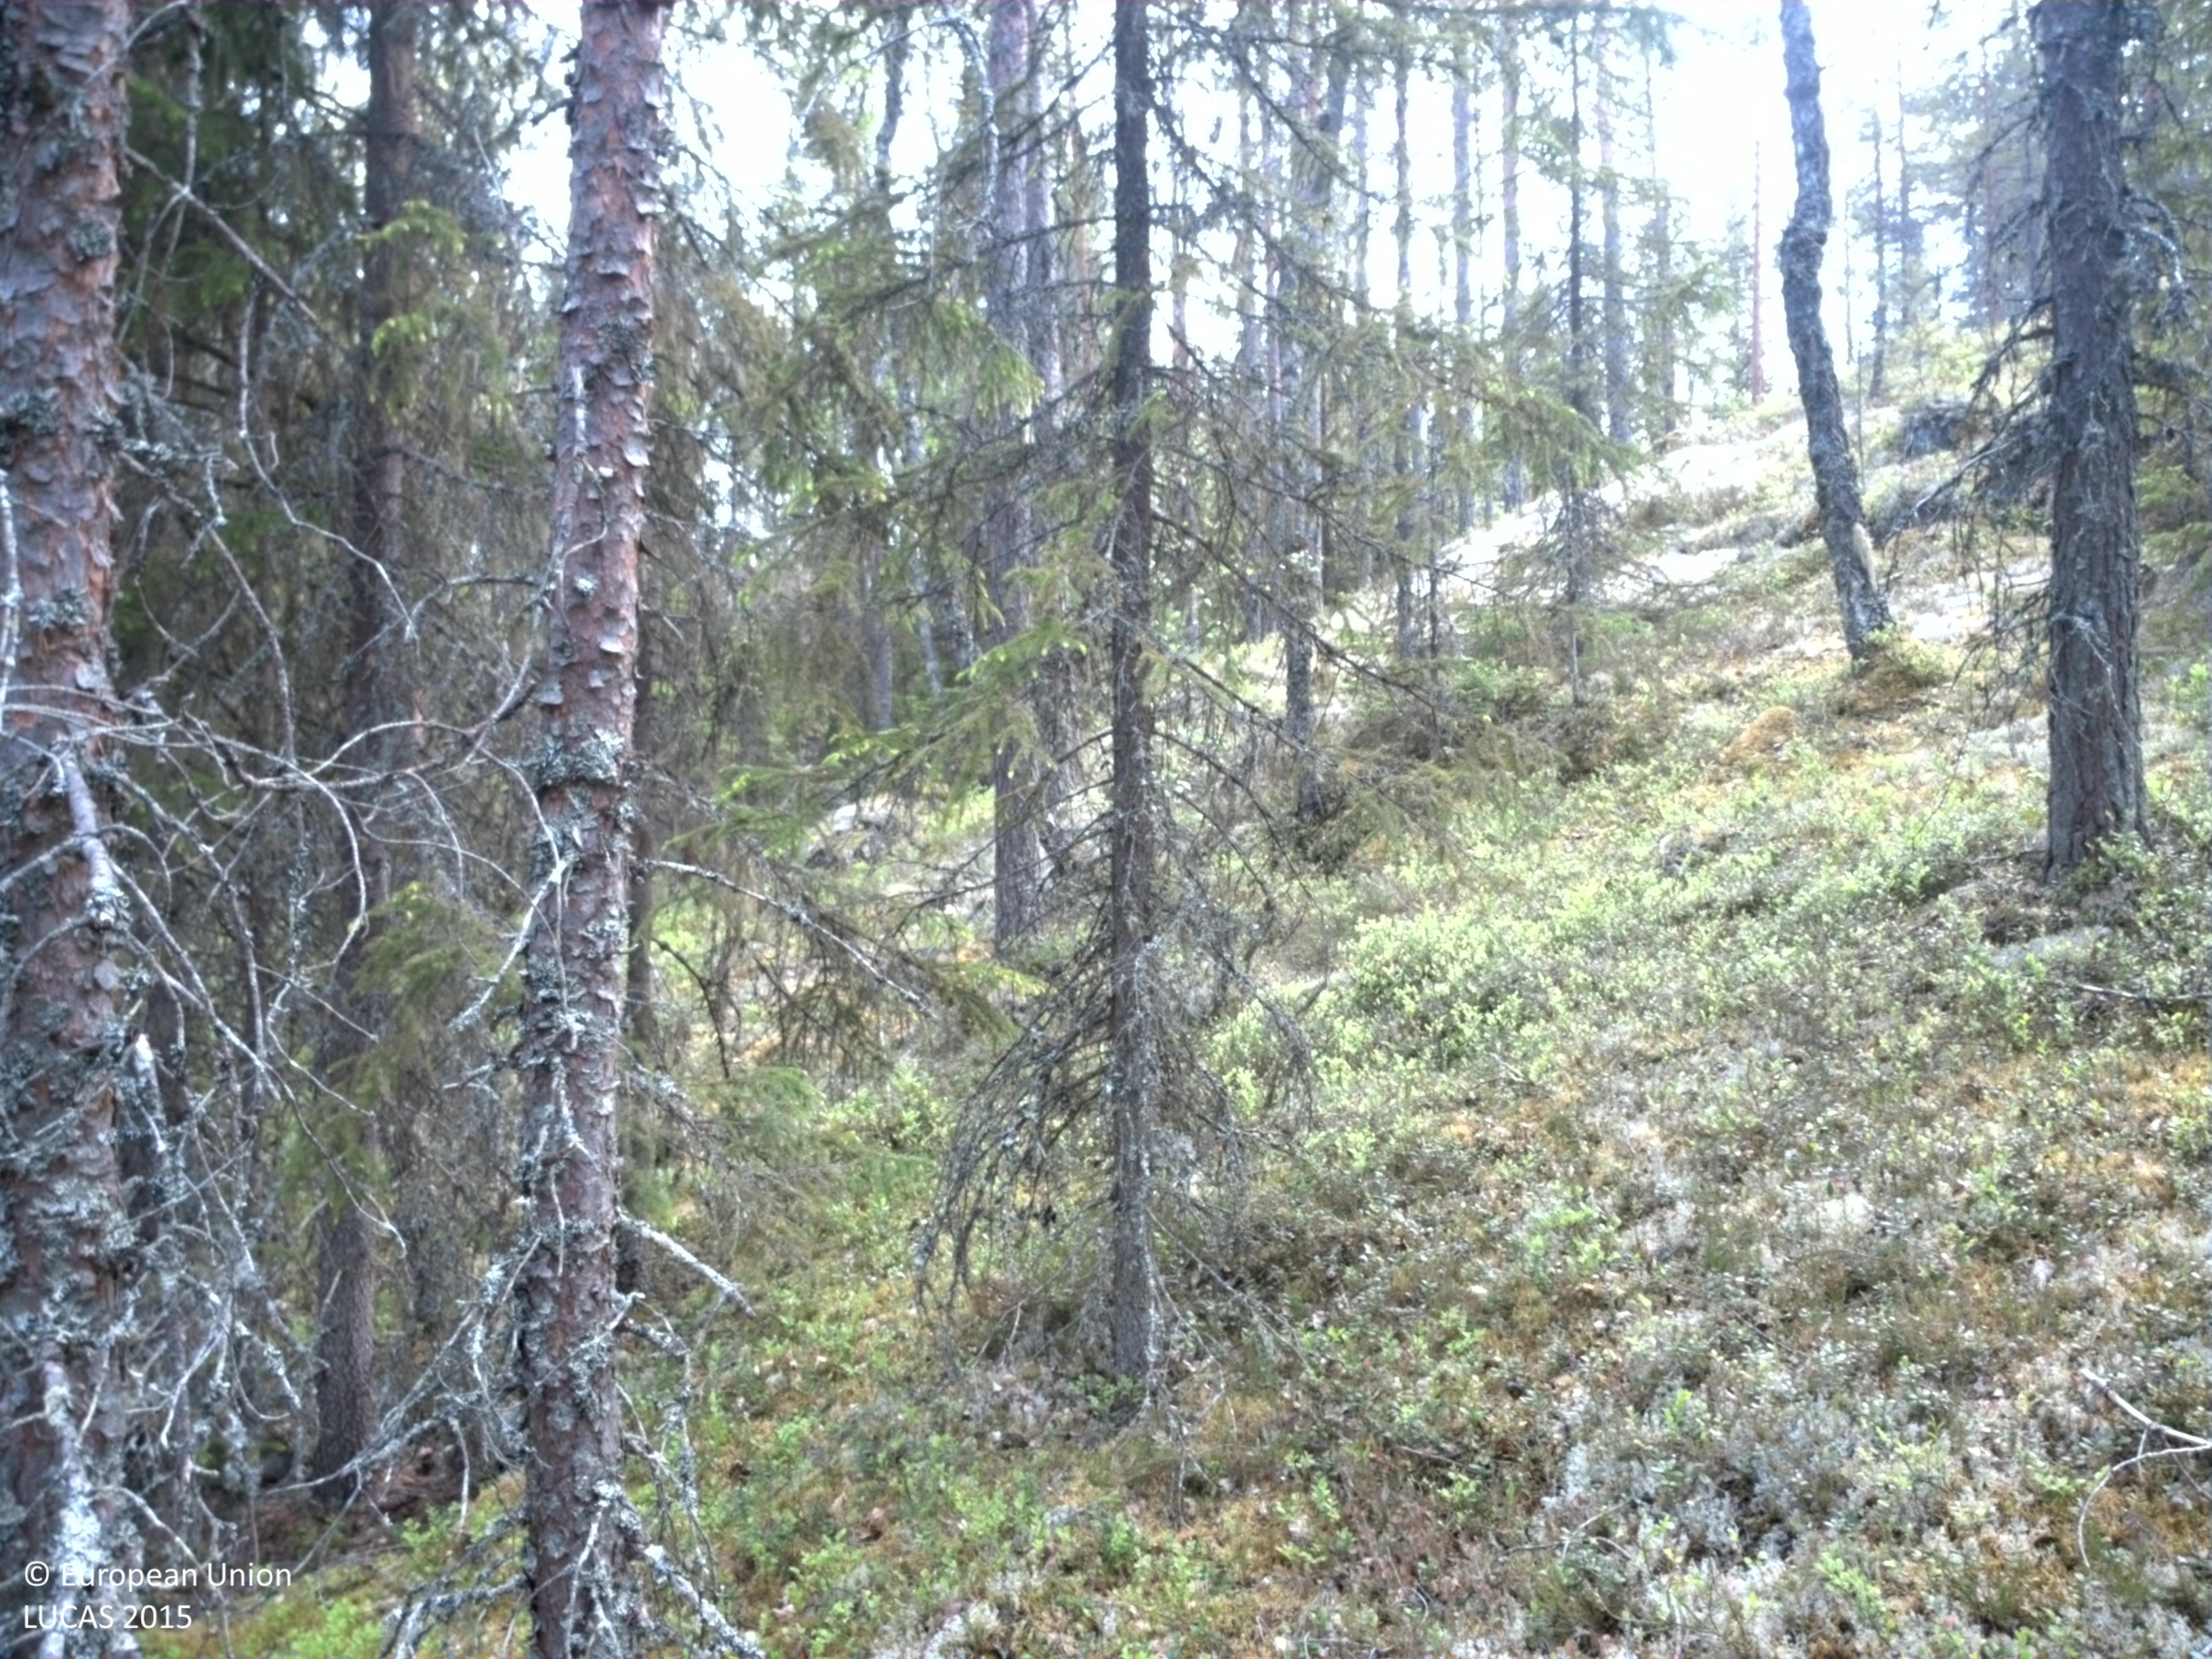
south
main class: Woodland
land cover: Other mixed woodland
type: boreal forest
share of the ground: 50 - 75 %
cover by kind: coniferous forest trees 55 %, broadleaved forest trees 20 %, lichens and mosses 15 %, herbaceous plants 10 %
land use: Forestry
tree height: > 5 m
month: June
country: SE
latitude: 61.3426
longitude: 13.5951
